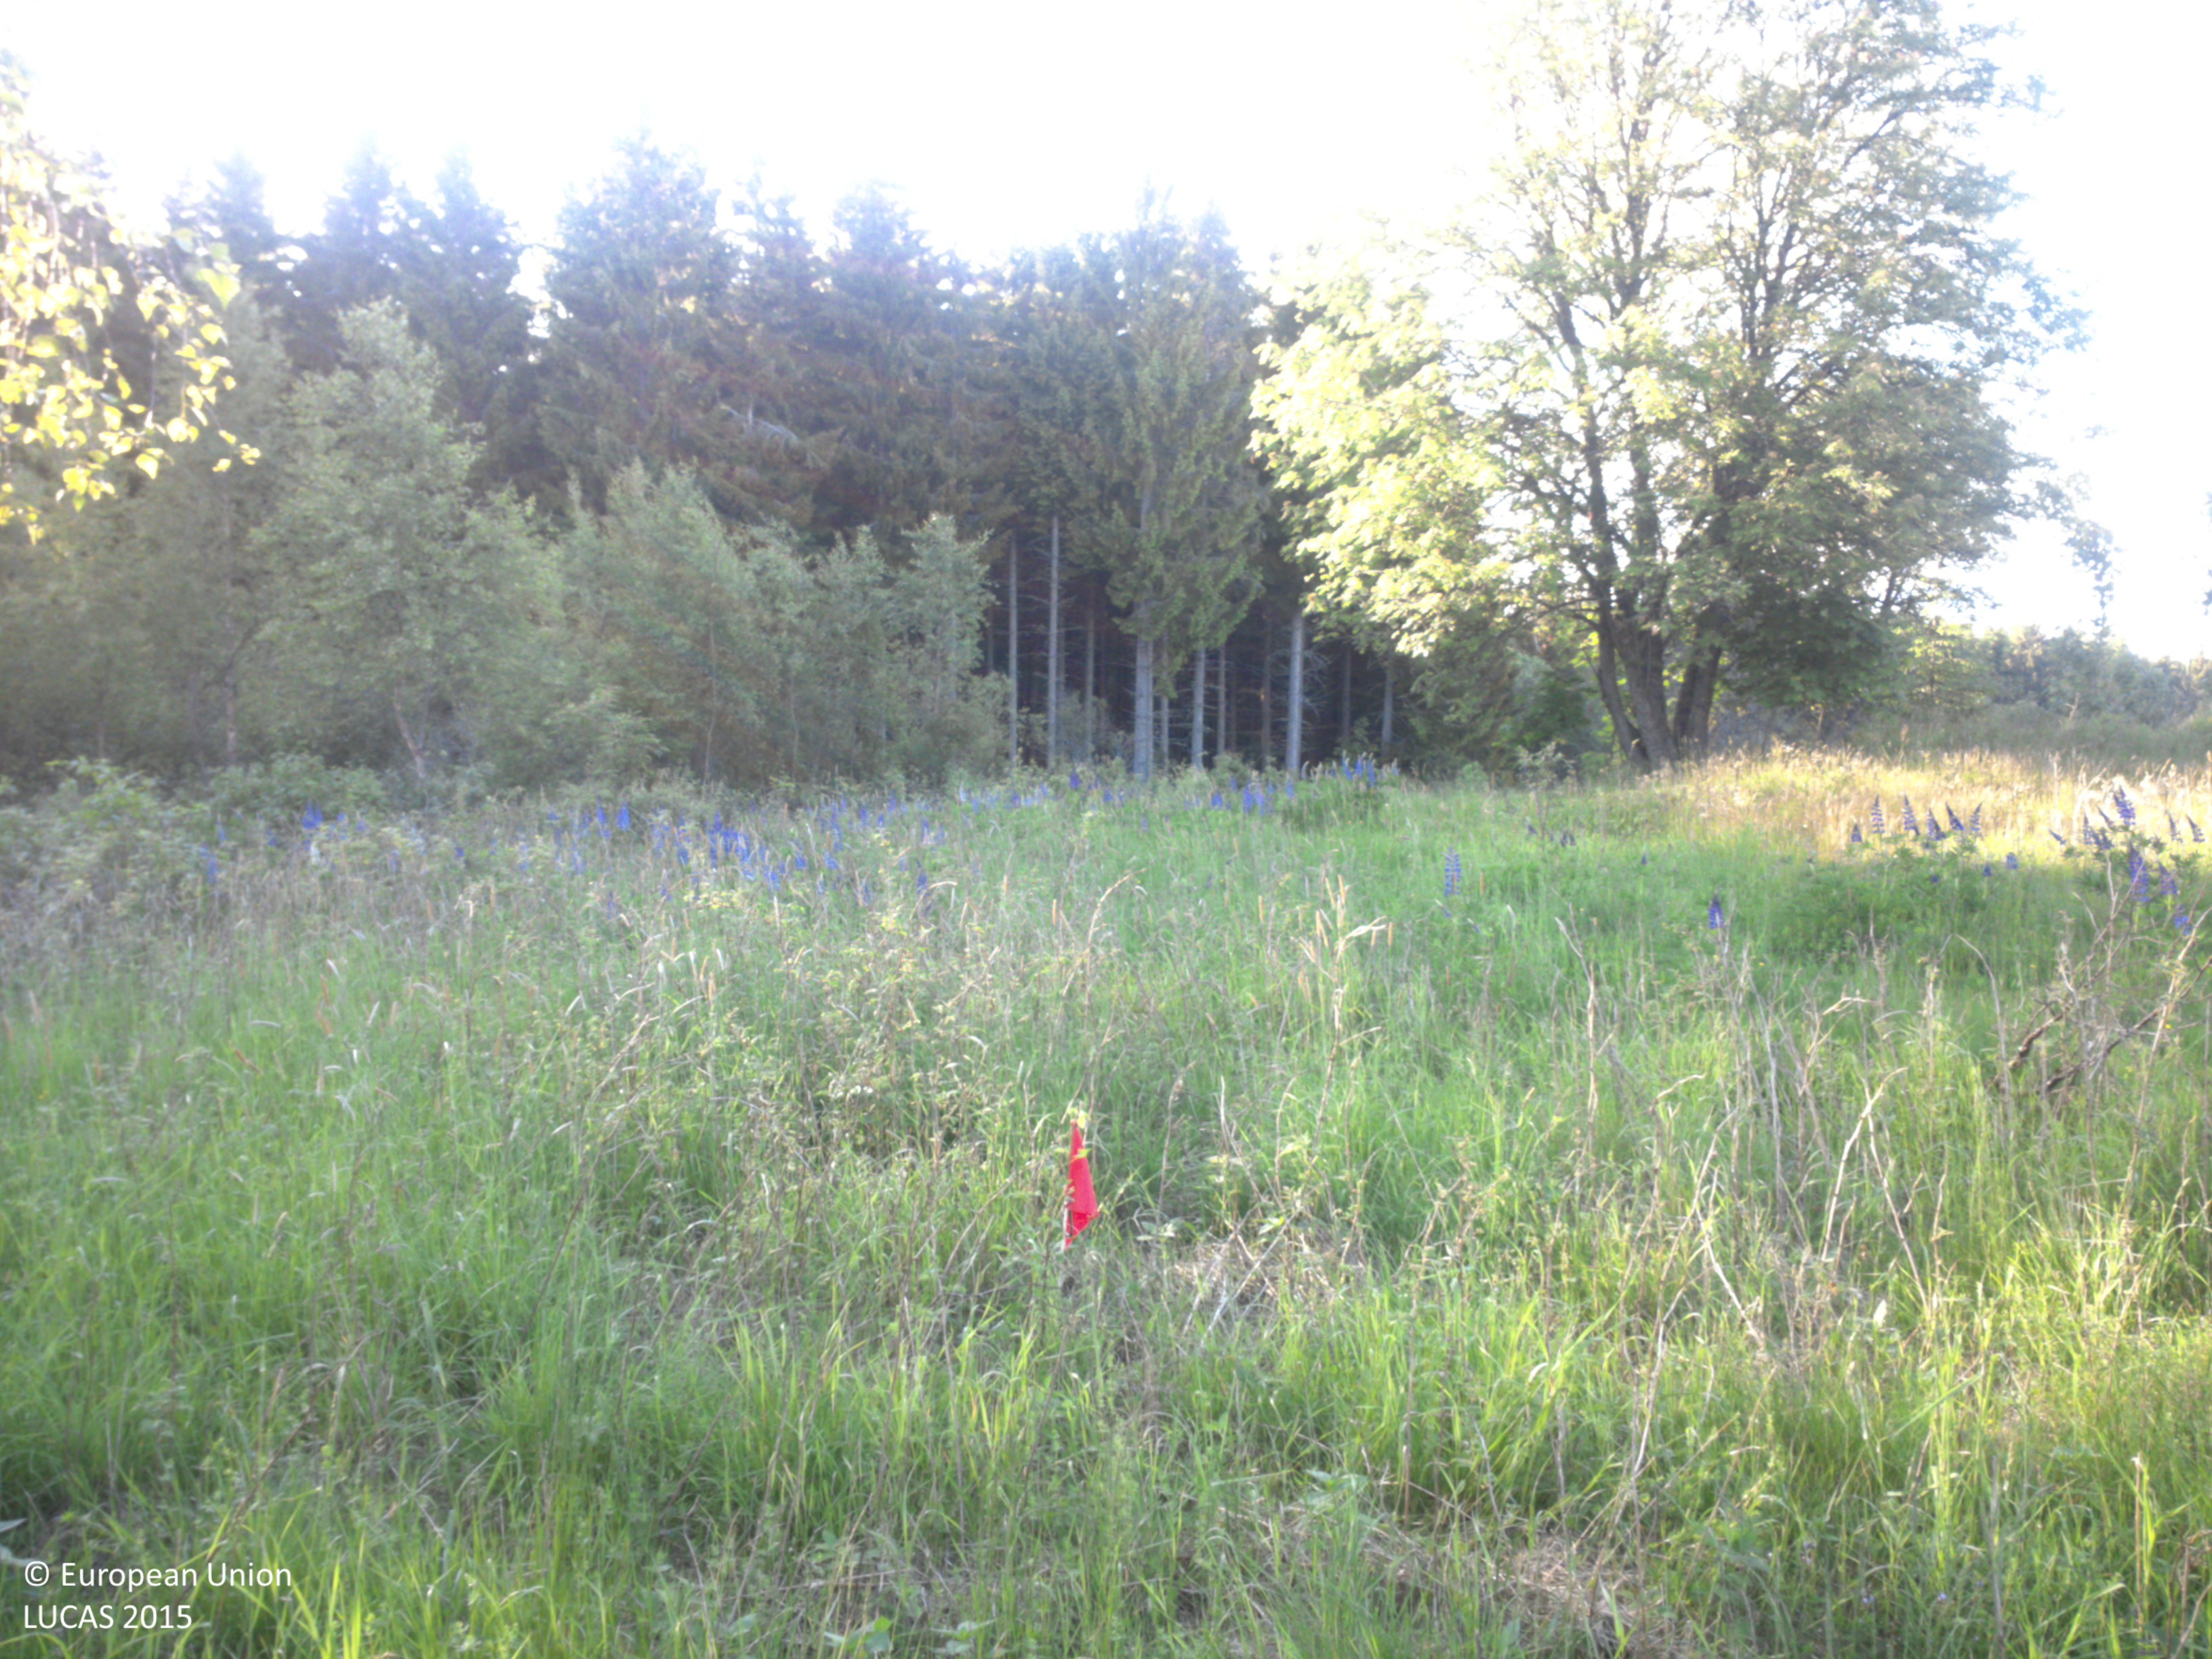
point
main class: Grassland
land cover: Spontaneously vegetated surfaces
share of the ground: > 75 %
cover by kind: herbaceous plants 95 %, shrubs 5 %
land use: Fallow land
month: June
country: SE
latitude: 58.9628
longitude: 11.8215
